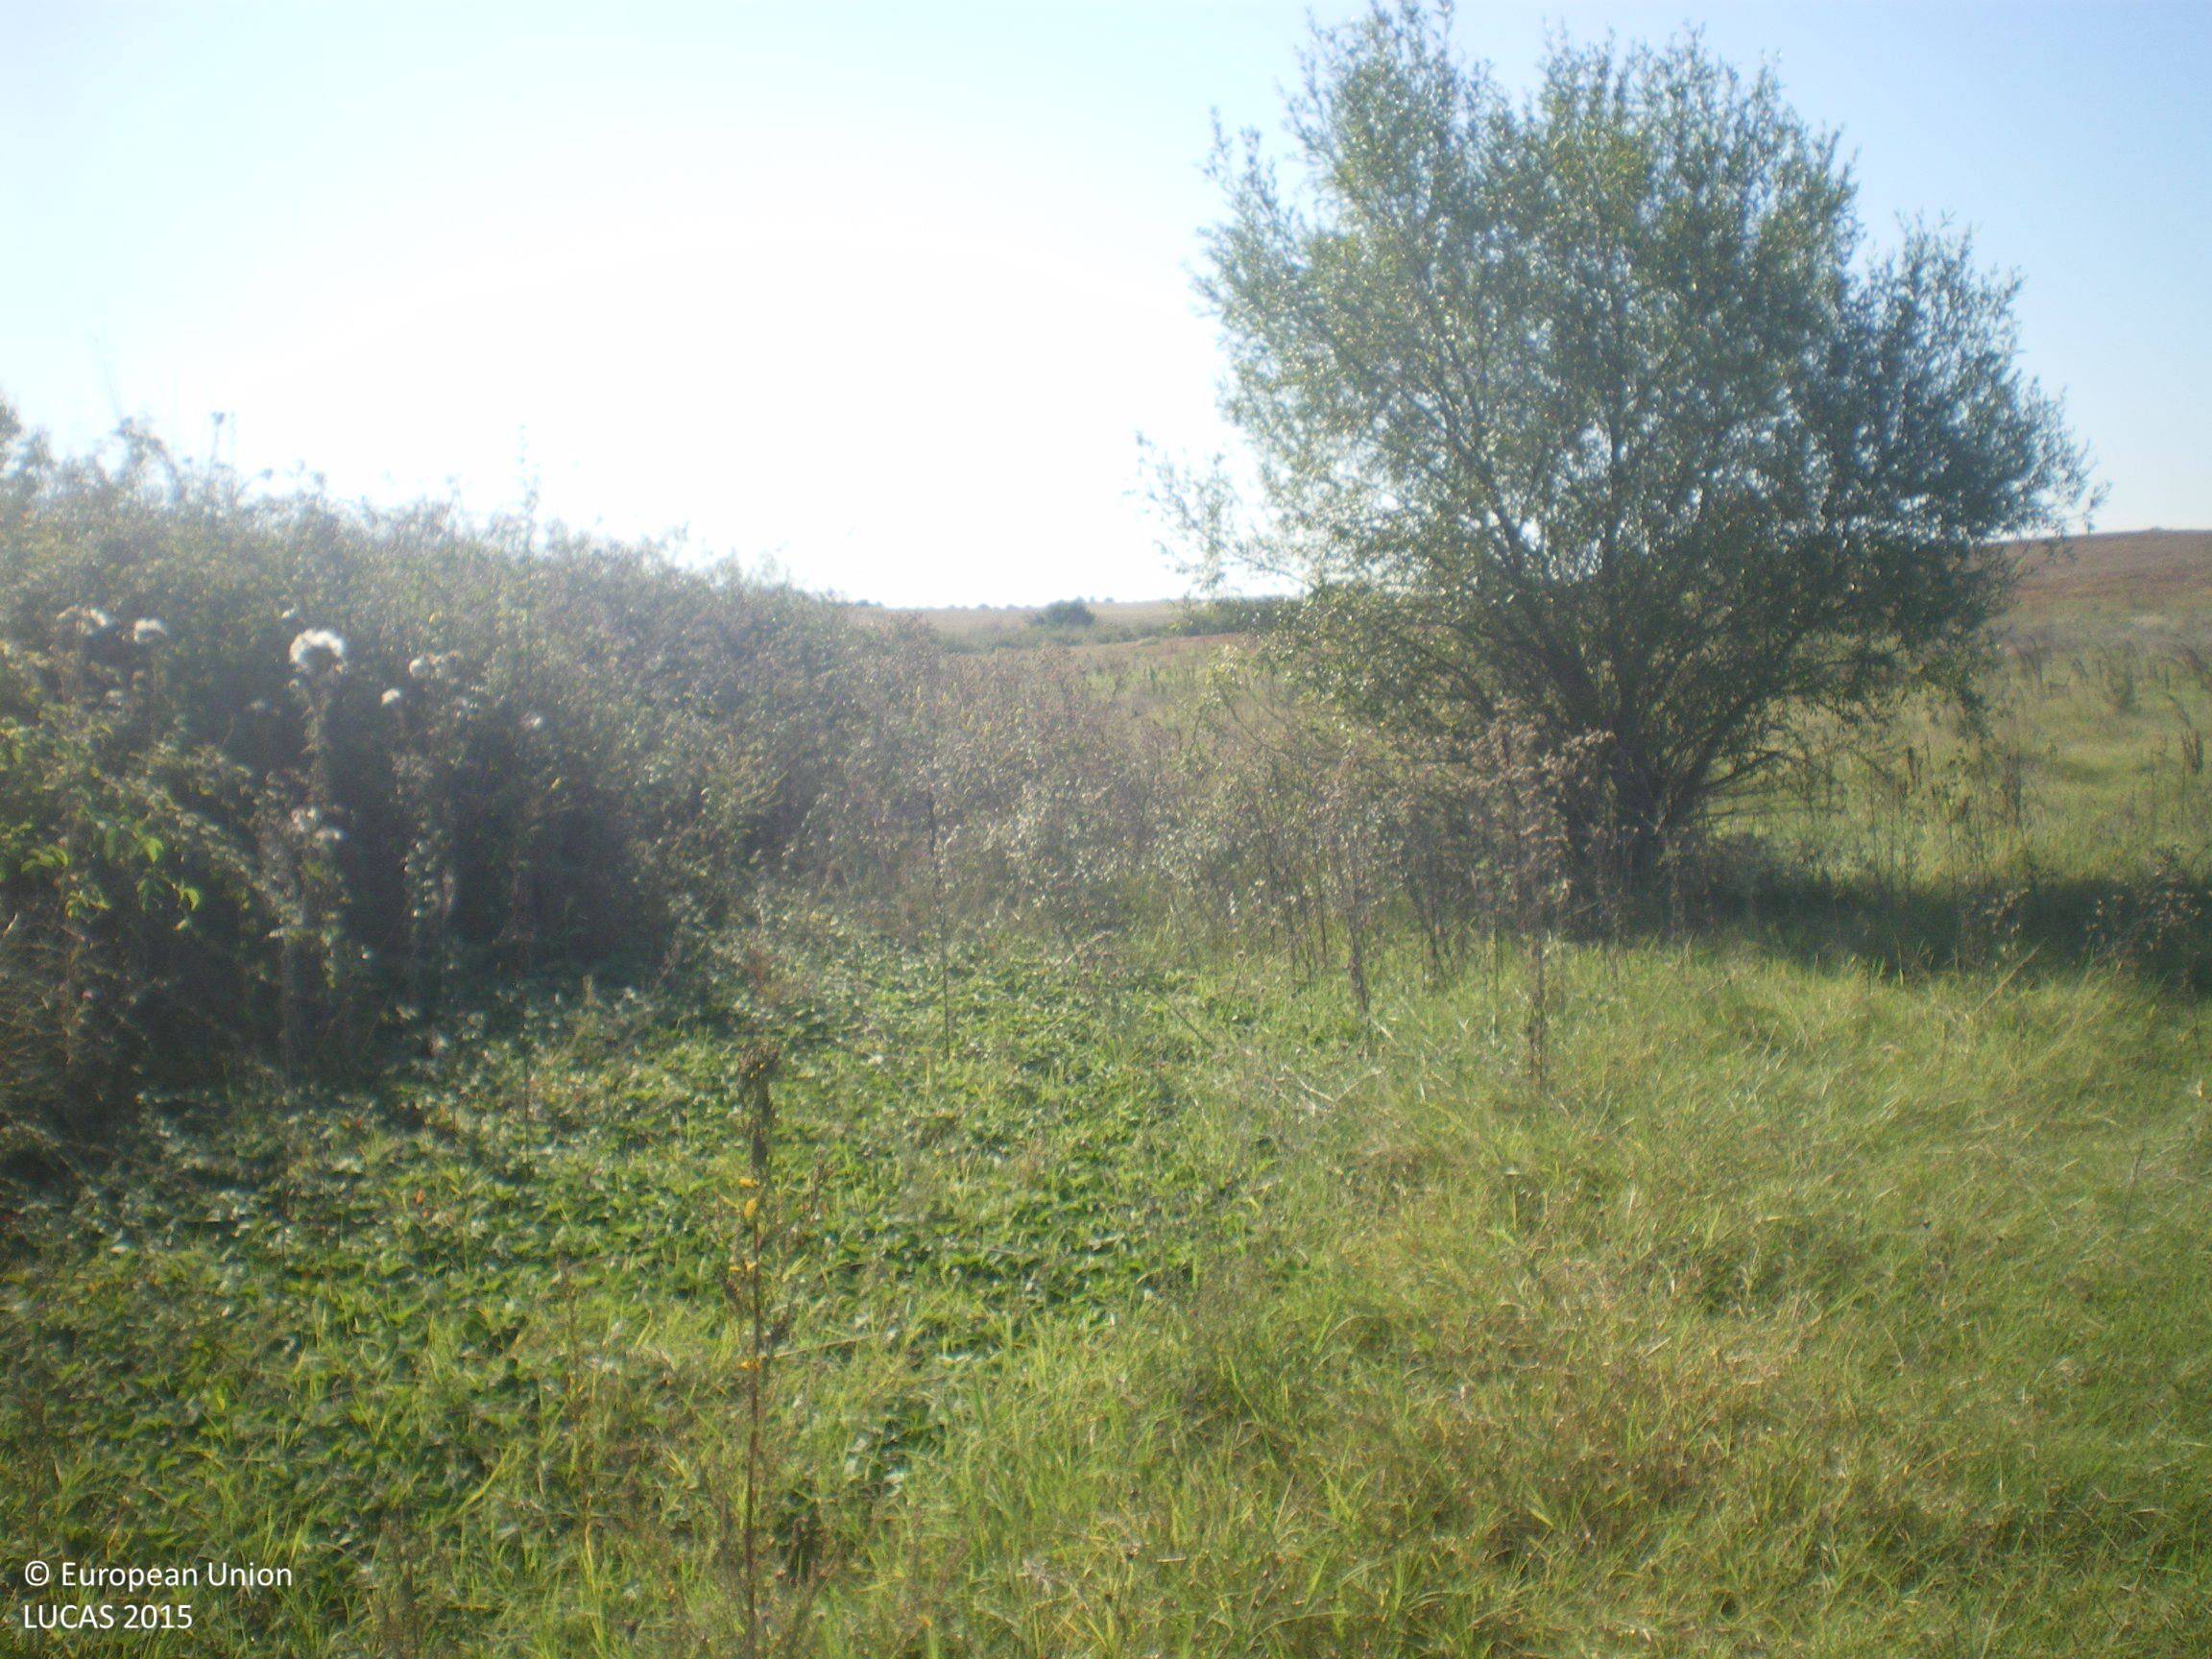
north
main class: Grassland
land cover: Grassland with sparse tree/shrub cover
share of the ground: > 75 %
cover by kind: herbaceous plants 85 %, shrubs 10 %, broadleaved forest trees 5 %
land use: Agriculture (excluding fallow land and kitchen gardens)
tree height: > 5 m
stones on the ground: < 10 %
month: September
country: BG
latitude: 41.8453
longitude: 26.0309
